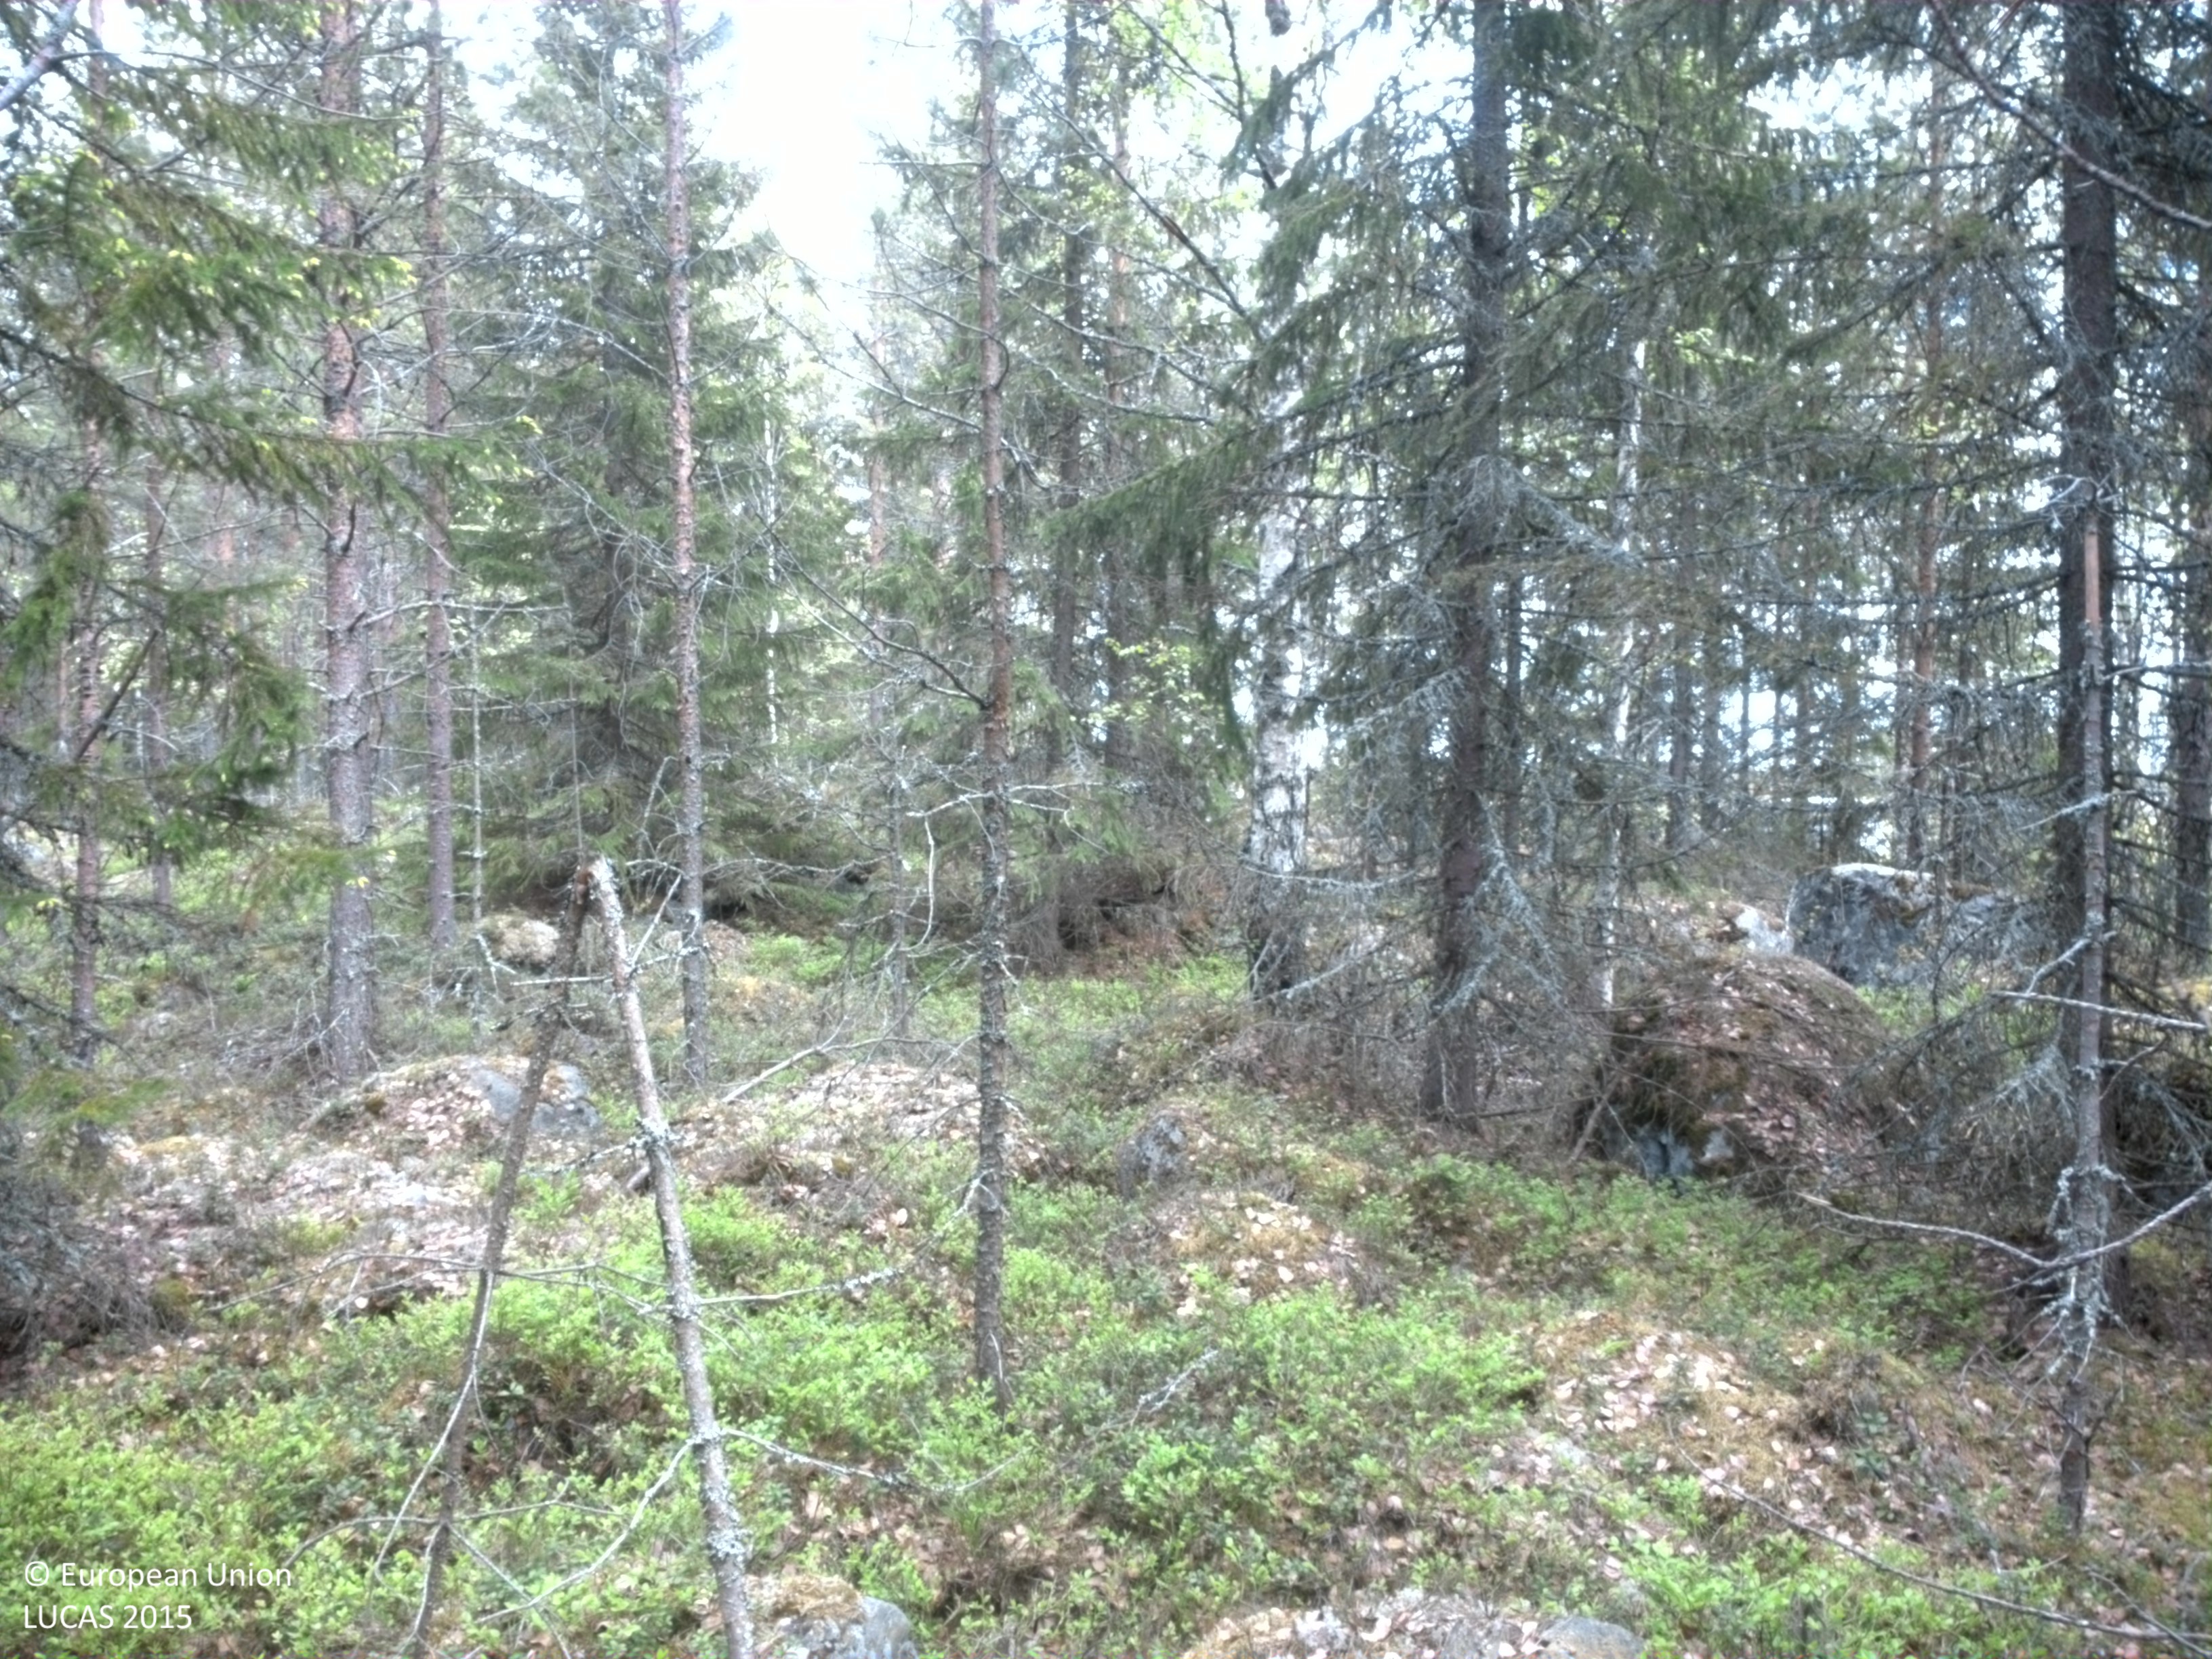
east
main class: Woodland
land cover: Pine dominated coniferous woodland
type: boreal forest
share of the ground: 50 - 75 %
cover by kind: coniferous forest trees 65 %, shrubs 20 %, broadleaved forest trees 10 %, lichens and mosses 5 %
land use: Forestry
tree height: > 5 m
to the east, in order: Pine dominated coniferous woodland; Spruce dominated mixed woodland; Other mixed woodland; Paved roads, cycling and walking lanes; Grassland with sparse tree/shrub cover; Shrubland with sparse tree cover; Lichens and moss; Shrubland with sparse tree cover; Grassland with sparse tree/shrub cover; Shrubland with sparse tree cover
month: June
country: SE
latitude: 63.9652
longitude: 20.6633
